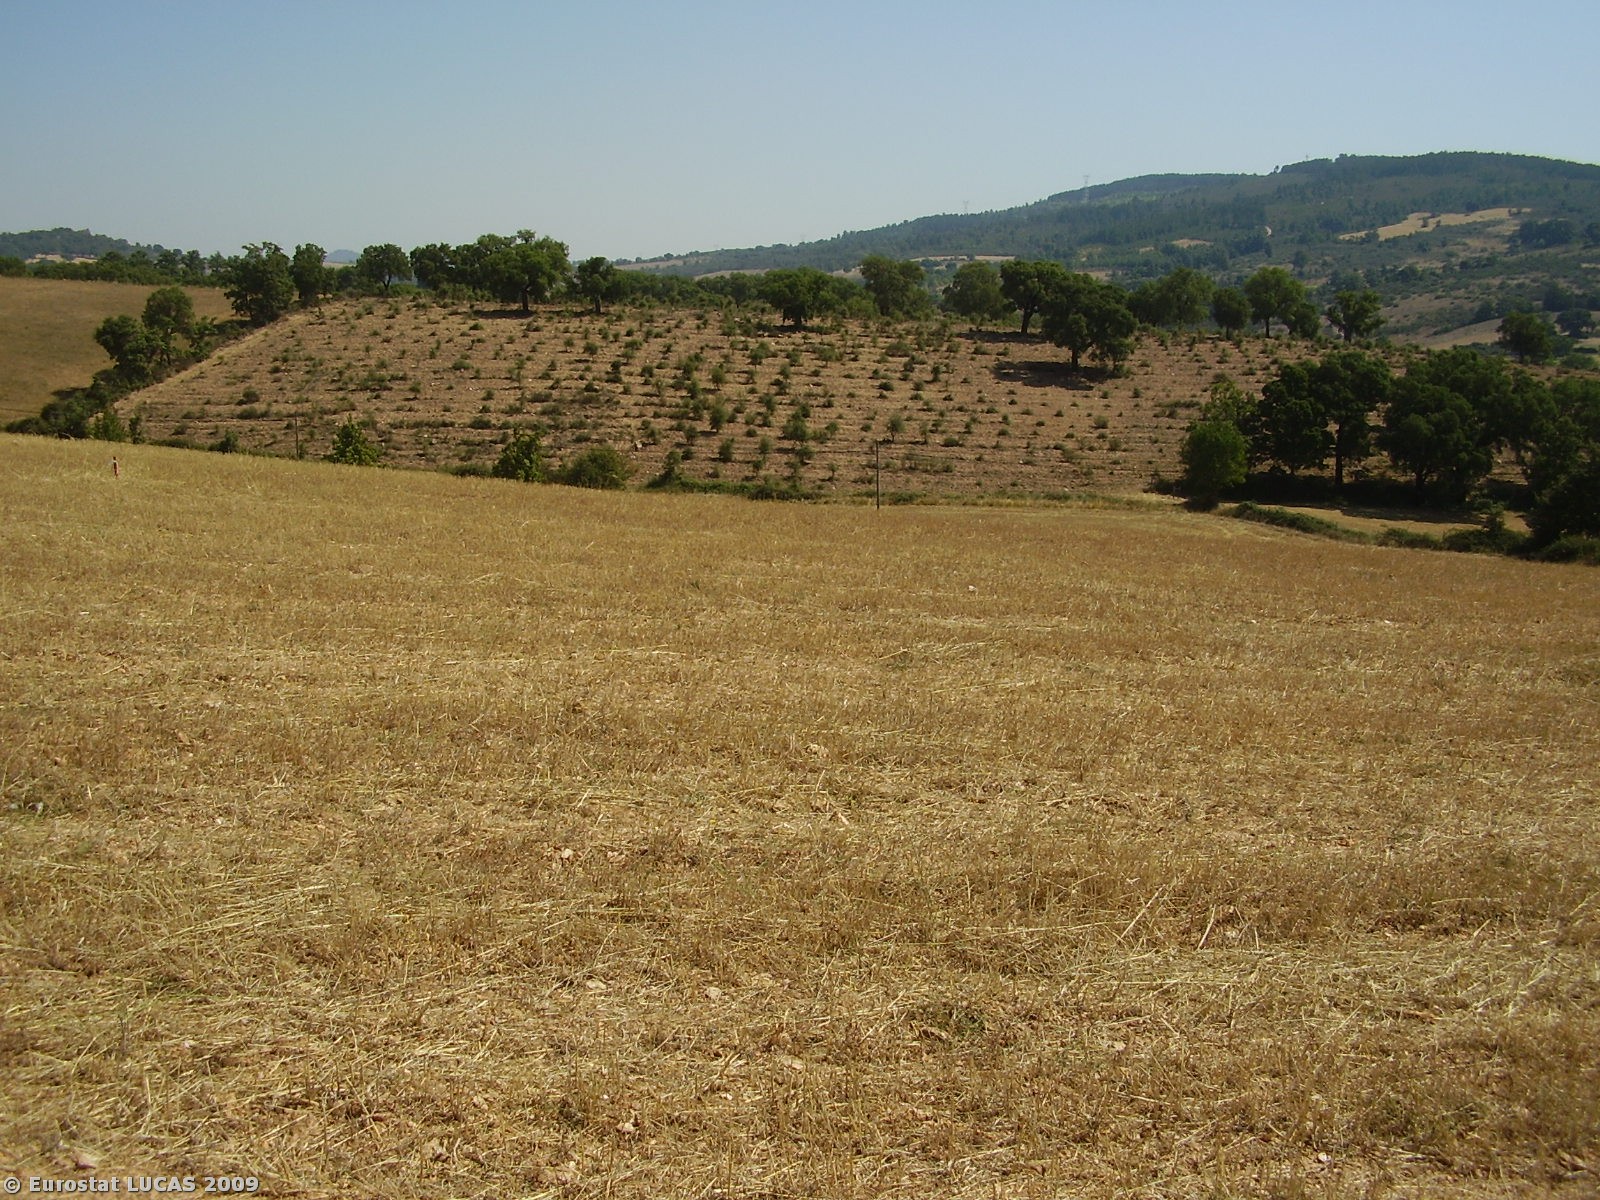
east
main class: Cropland
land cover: Common wheat
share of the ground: < 10 %
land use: Agriculture (excluding fallow land and kitchen gardens)
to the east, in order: Common wheat; Electric lines; Common wheat; Tracks; Shrubland without tree cover; Fences; Grassland without tree/shrub cover; Fences; Broadleaved woodland
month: August
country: PT
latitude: 41.3079
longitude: -6.7194
